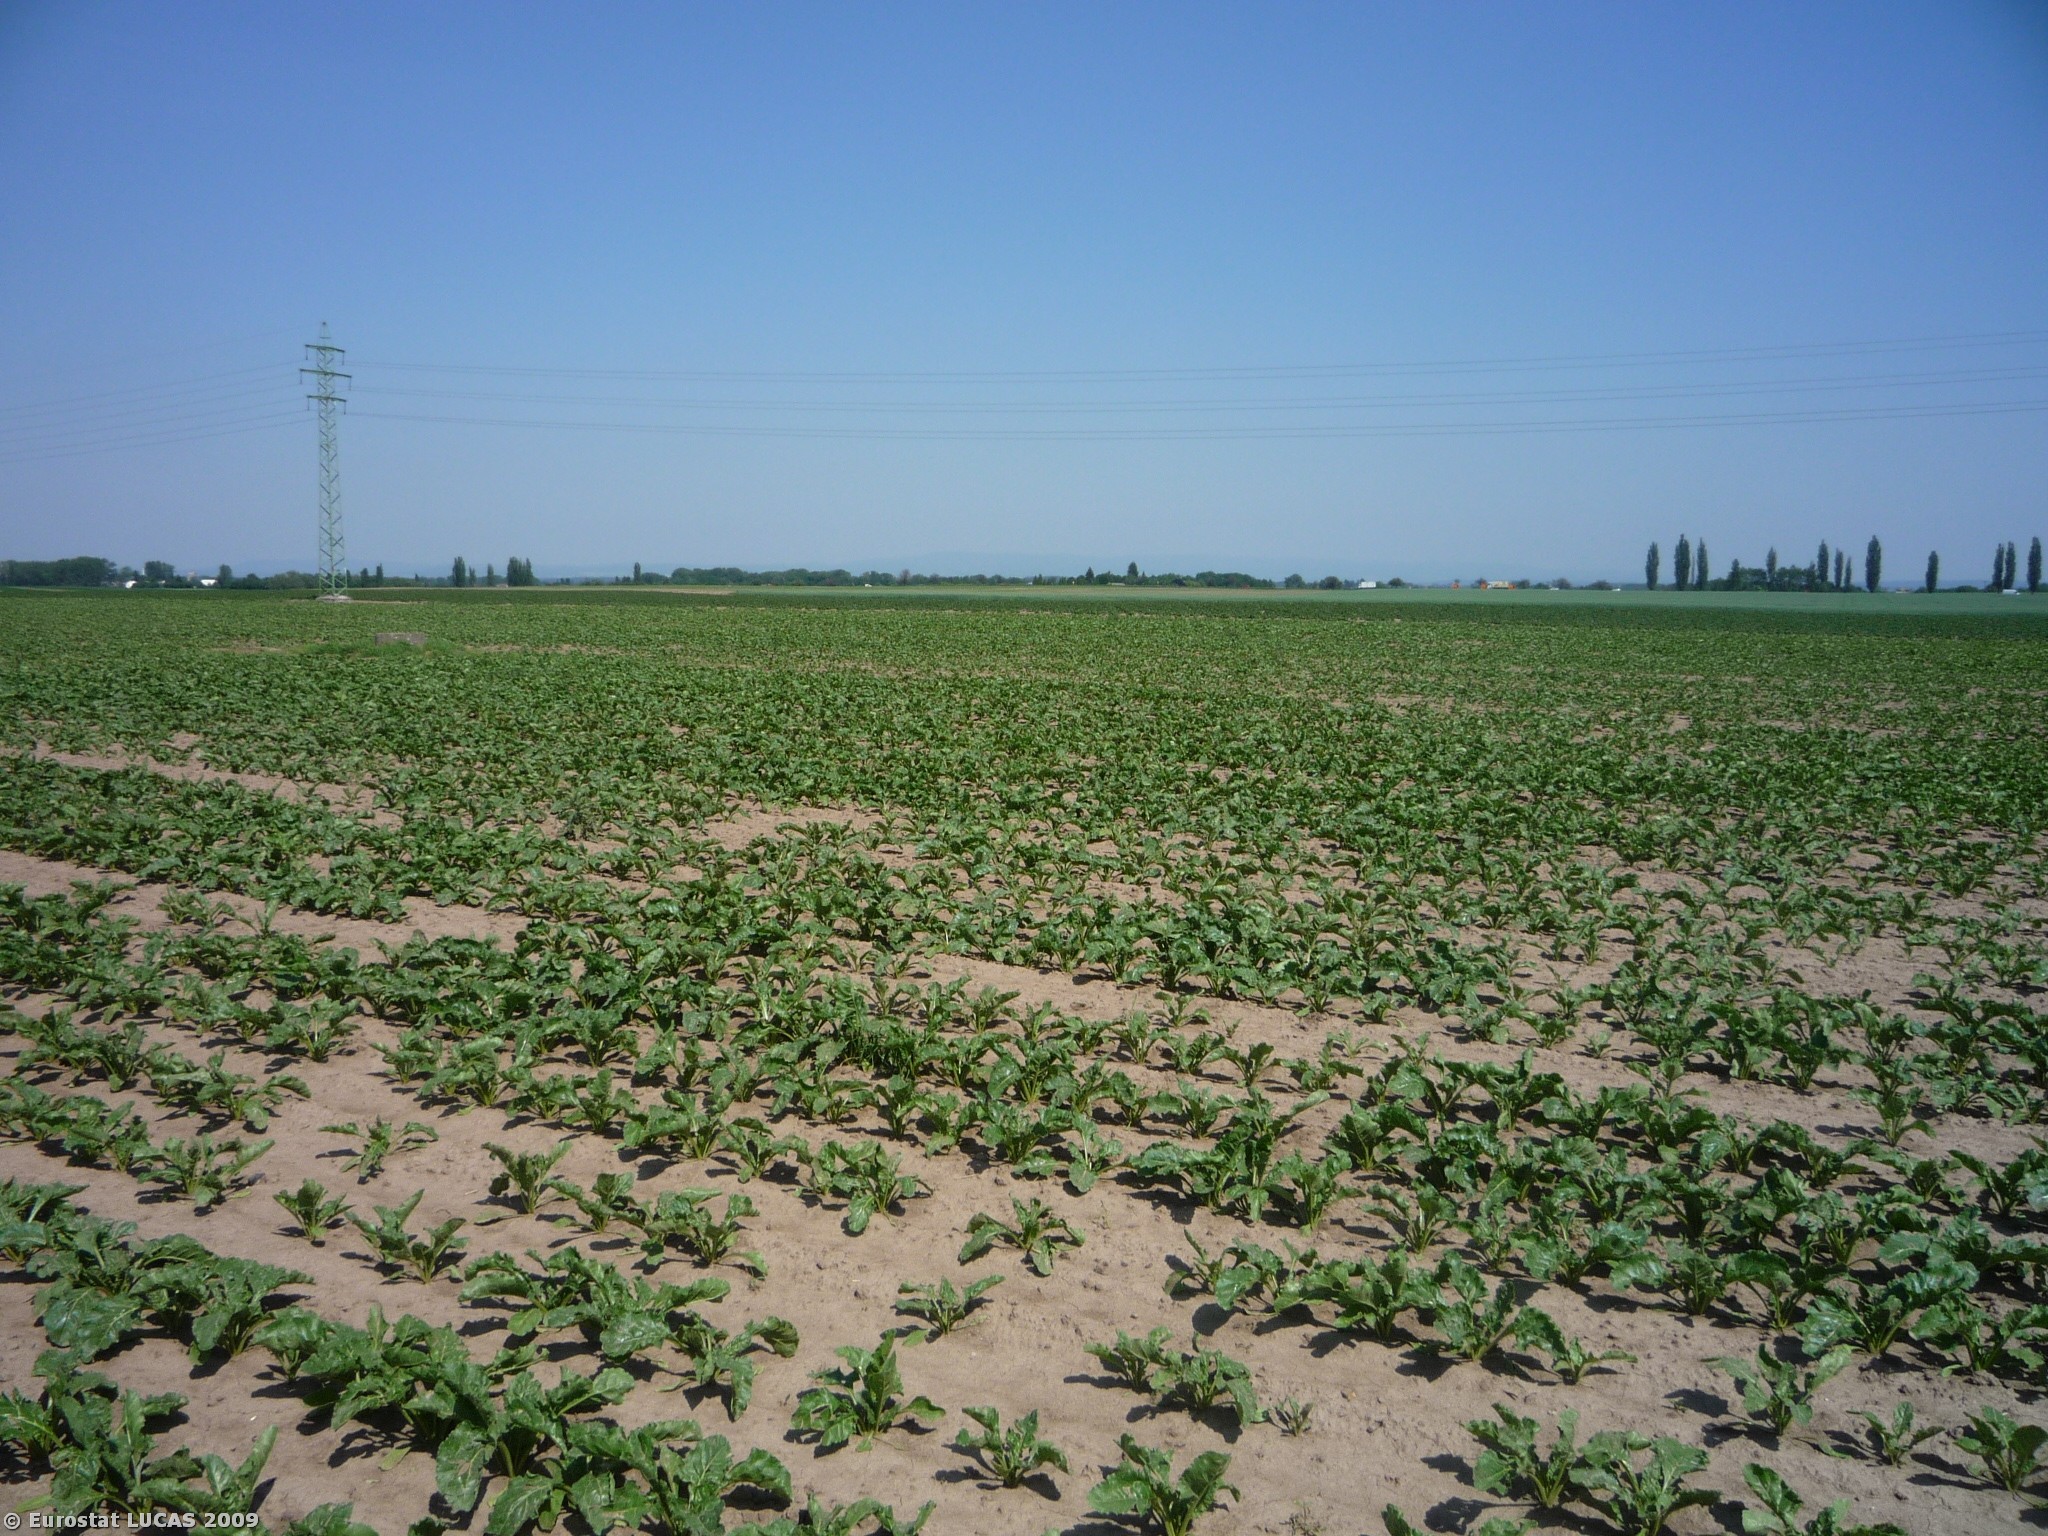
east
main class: Cropland
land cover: Sugar beet
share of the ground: 10 - 25 %
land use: Agriculture (excluding fallow land and kitchen gardens)
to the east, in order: Sugar beet; Electric lines; Potatoes; Common wheat
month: May
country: CZ
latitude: 50.2710
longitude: 15.7996
